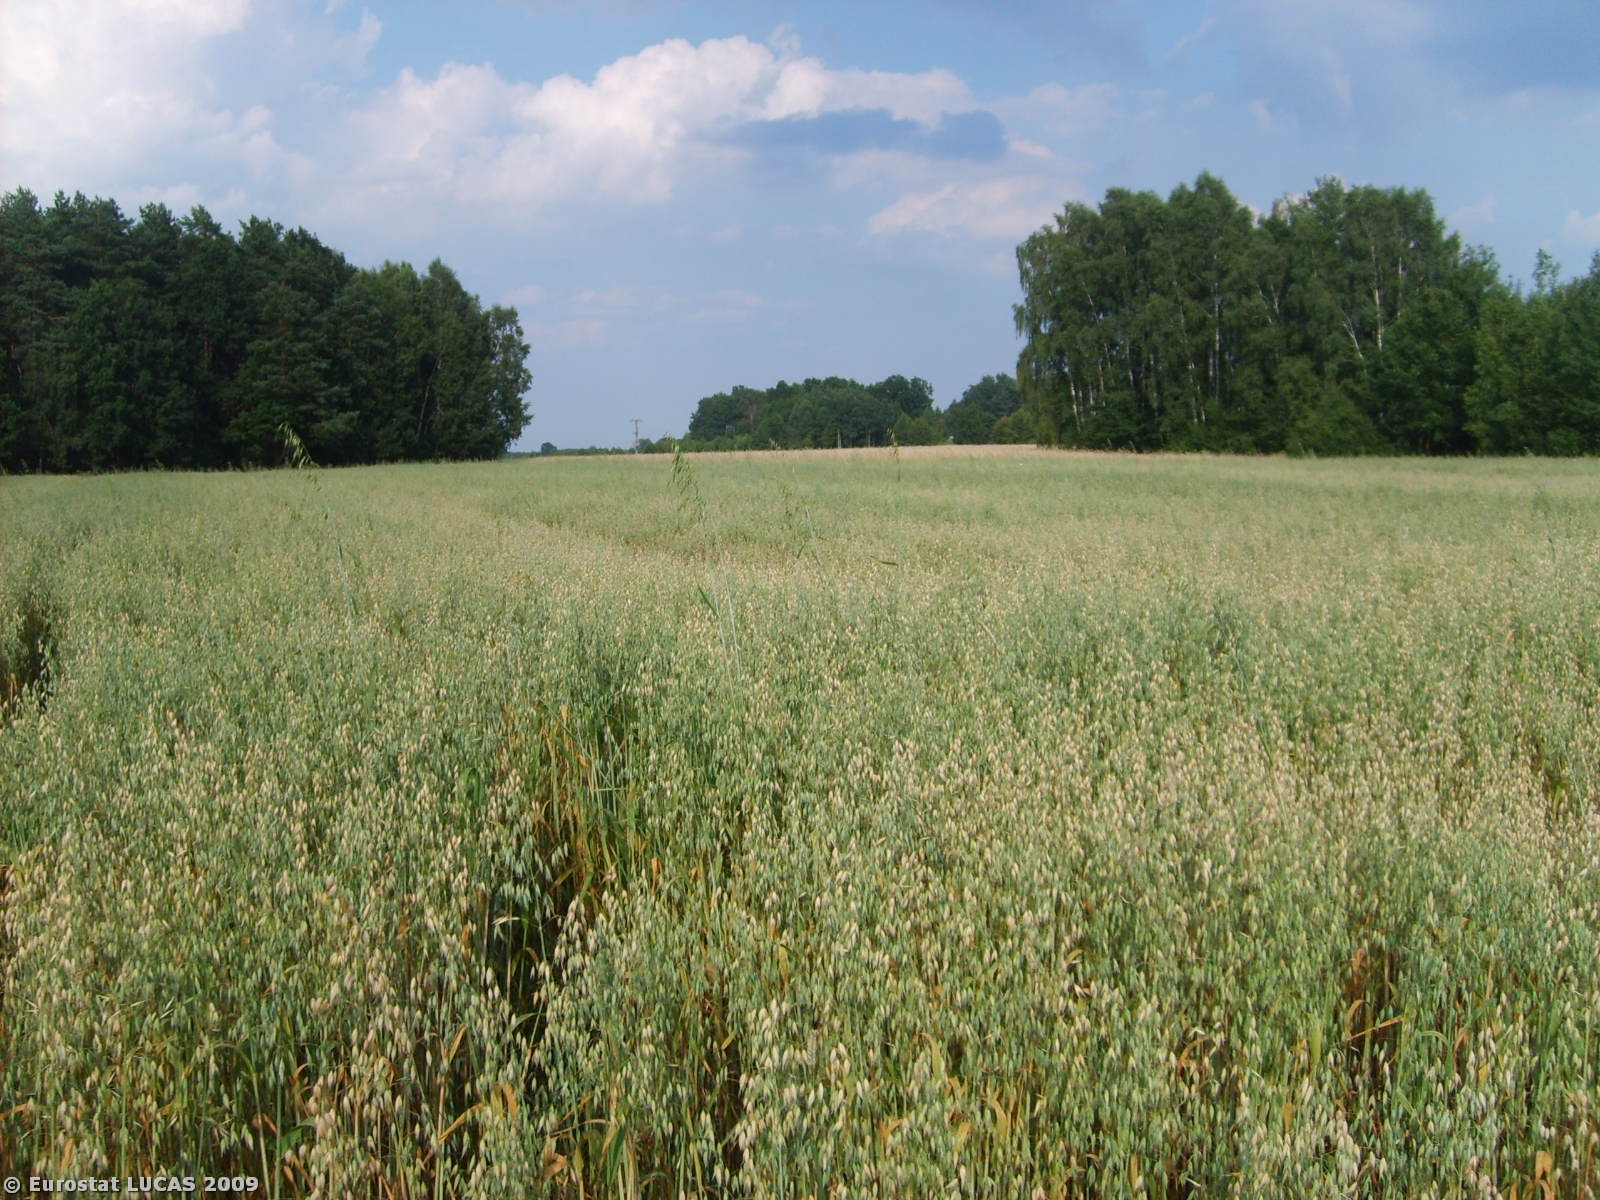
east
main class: Grassland
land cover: Grassland without tree/shrub cover
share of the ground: > 75 %
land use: Unused
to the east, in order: Grassland without tree/shrub cover; Oats; Grass margins; Tracks; Grass margins; Rye
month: July
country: PL
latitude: 52.4486
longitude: 21.7220
